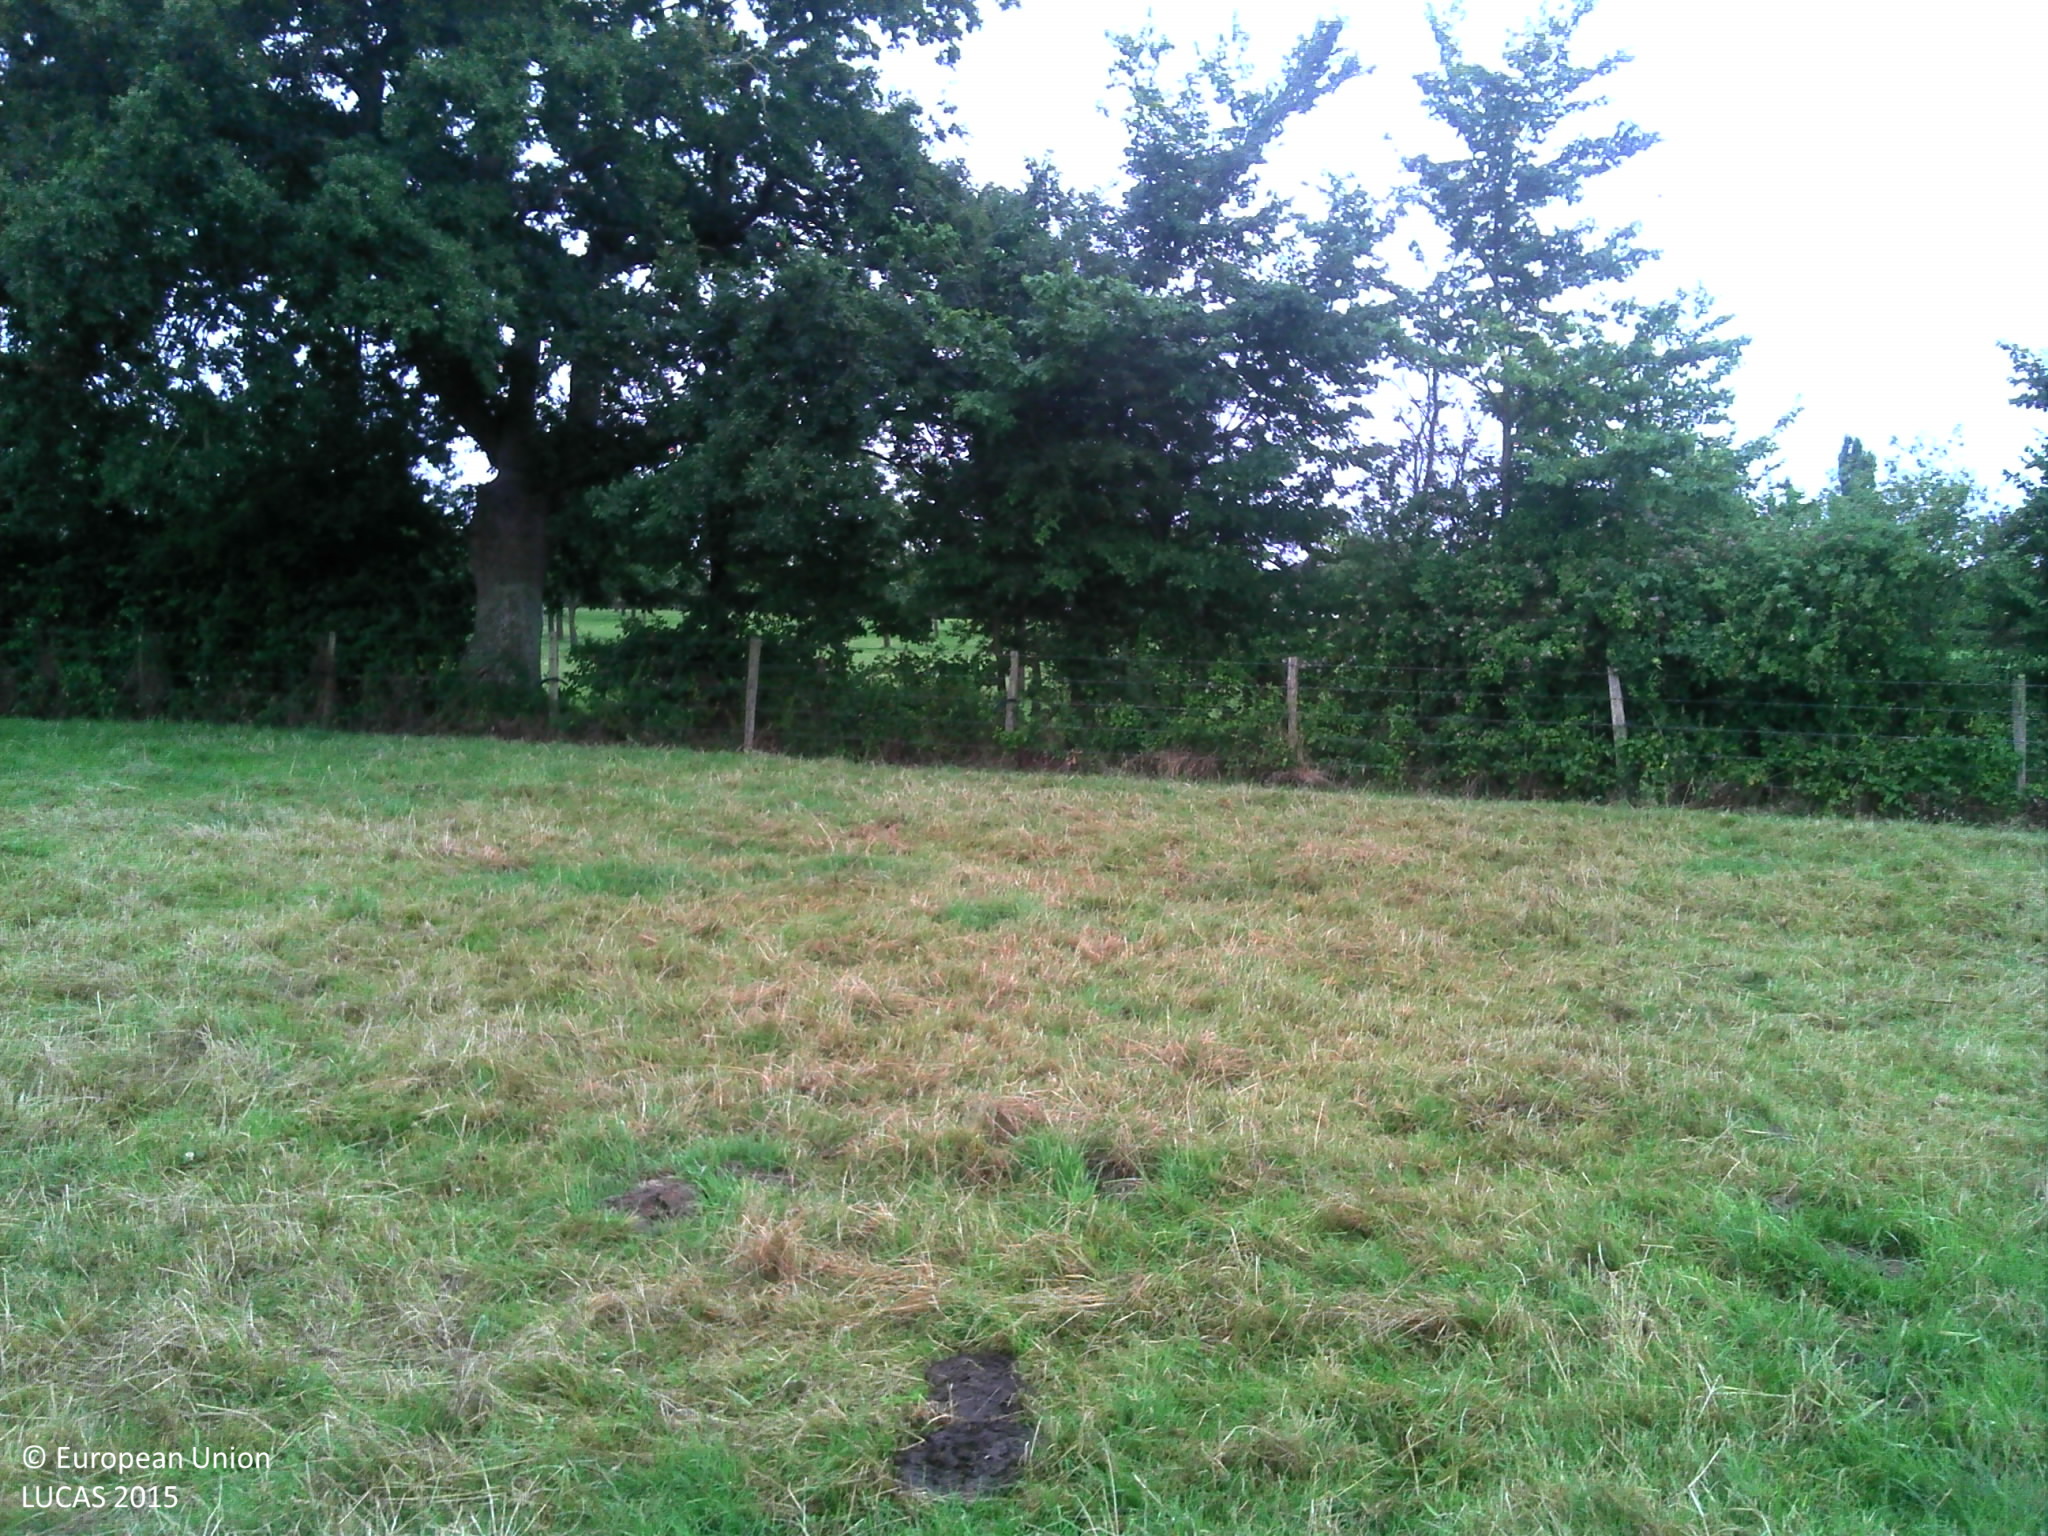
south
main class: Grassland
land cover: Grassland without tree/shrub cover
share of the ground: > 75 %
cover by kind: herbaceous plants 100 %
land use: Agriculture (excluding fallow land and kitchen gardens)
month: July
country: FR
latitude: 49.1101
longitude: 0.0099
